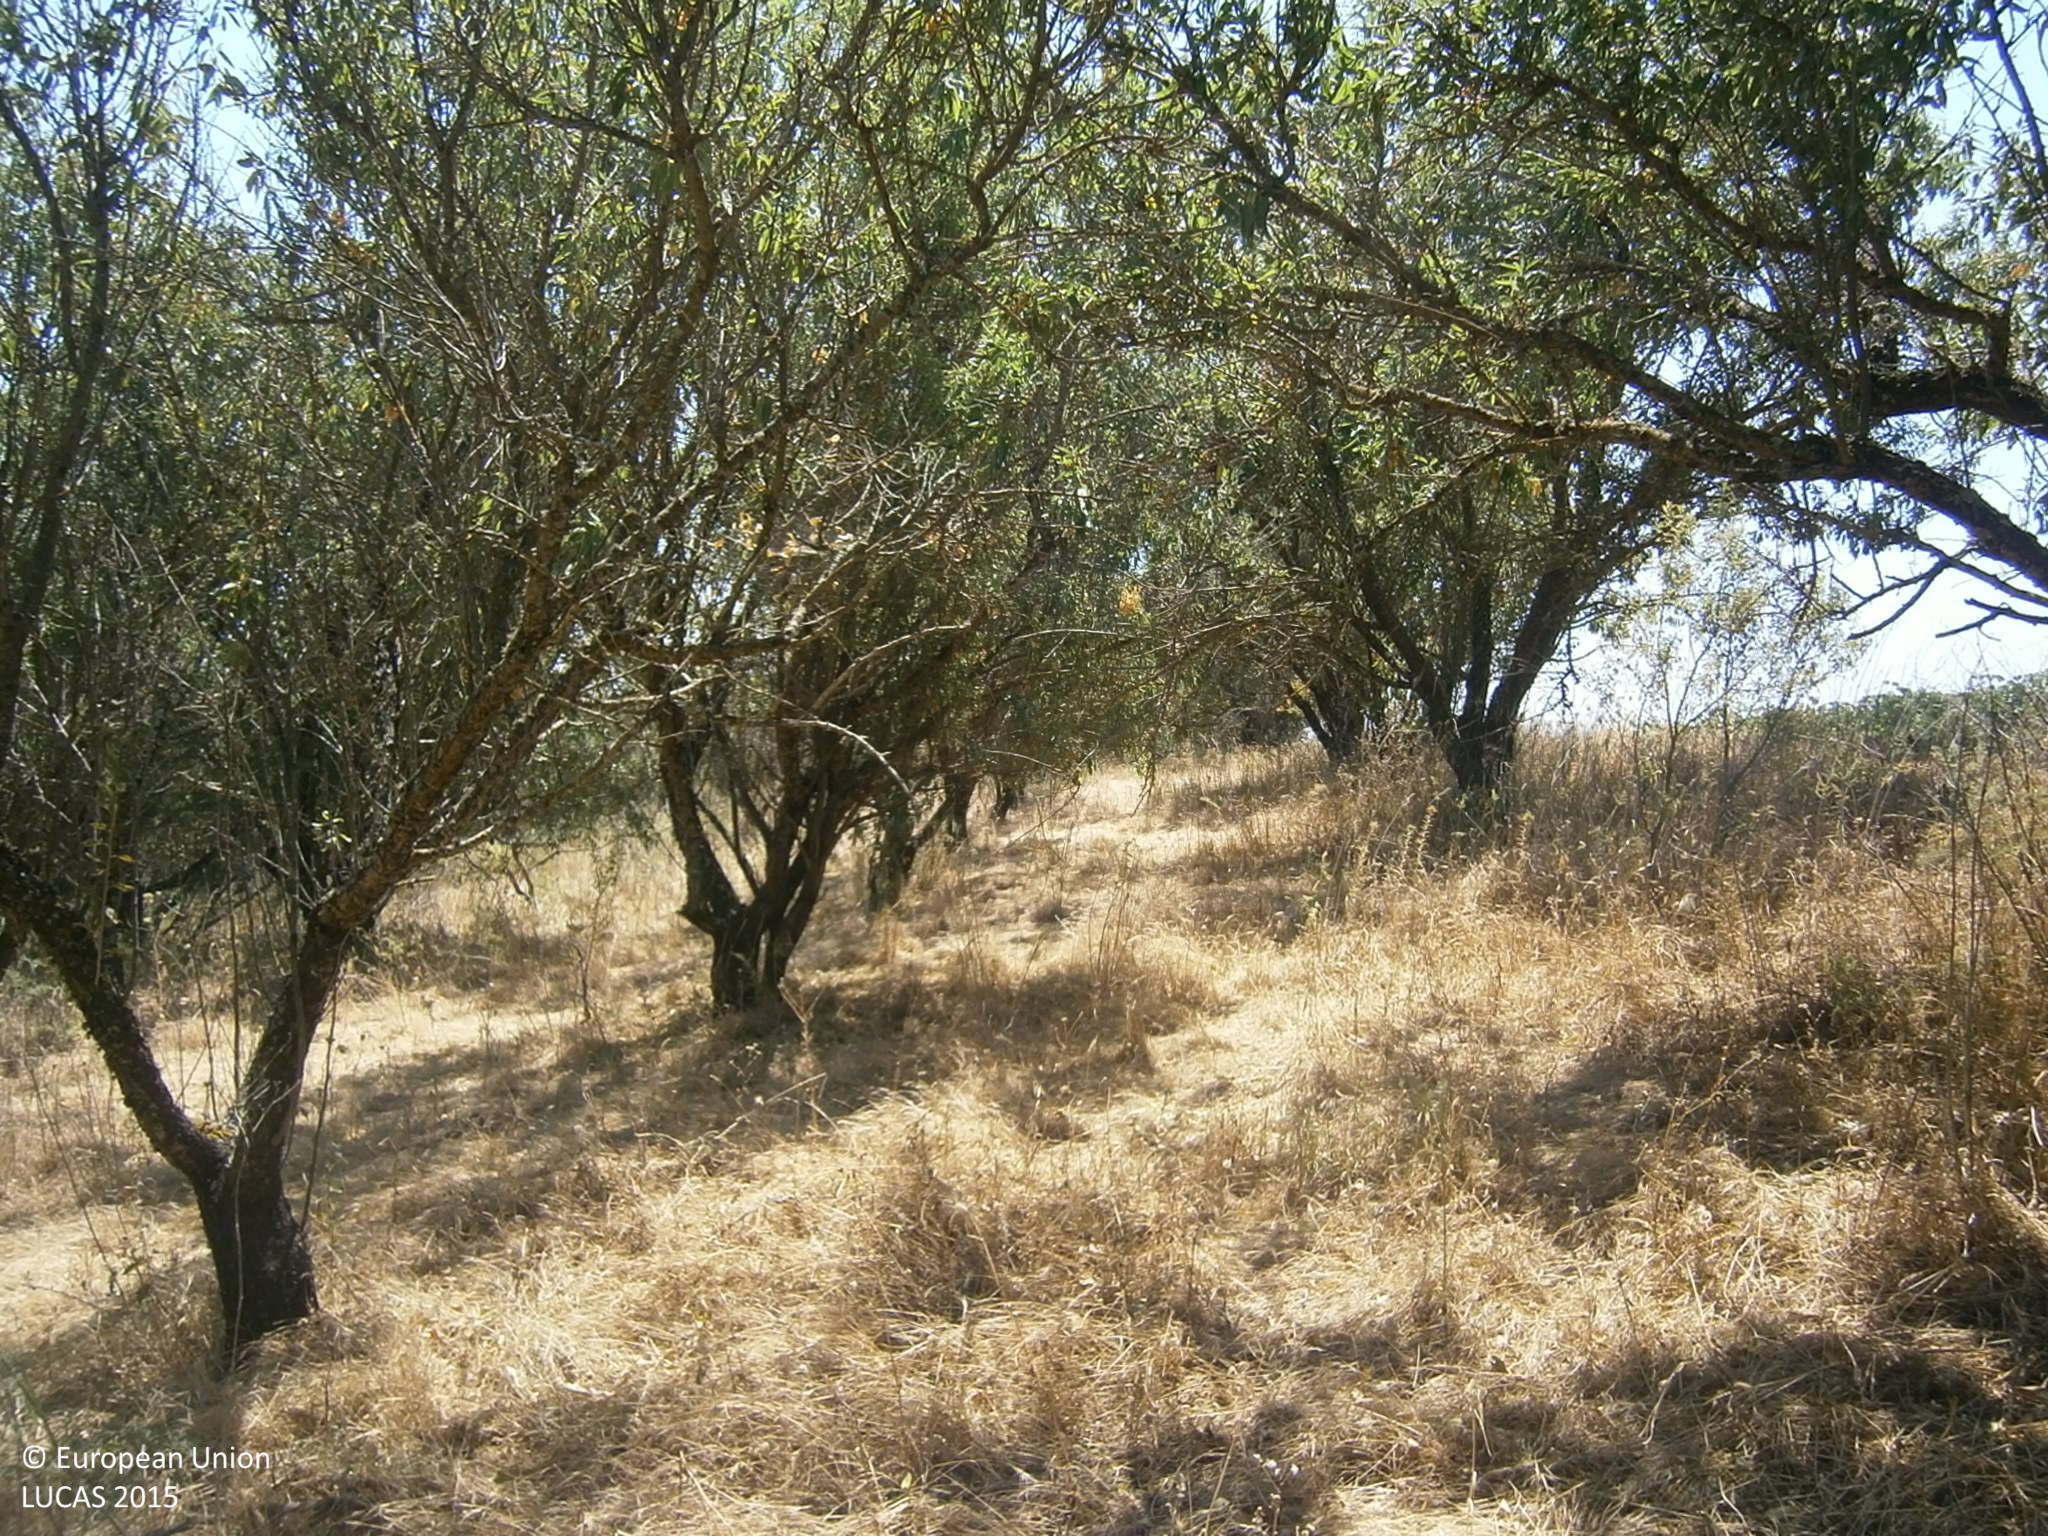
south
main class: Cropland
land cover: Nuts trees
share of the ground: > 75 %
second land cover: Spontaneously vegetated surfaces
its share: 25 - 50 %
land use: Agriculture (excluding fallow land and kitchen gardens)
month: June
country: ES
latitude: 38.8312
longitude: -6.6619
